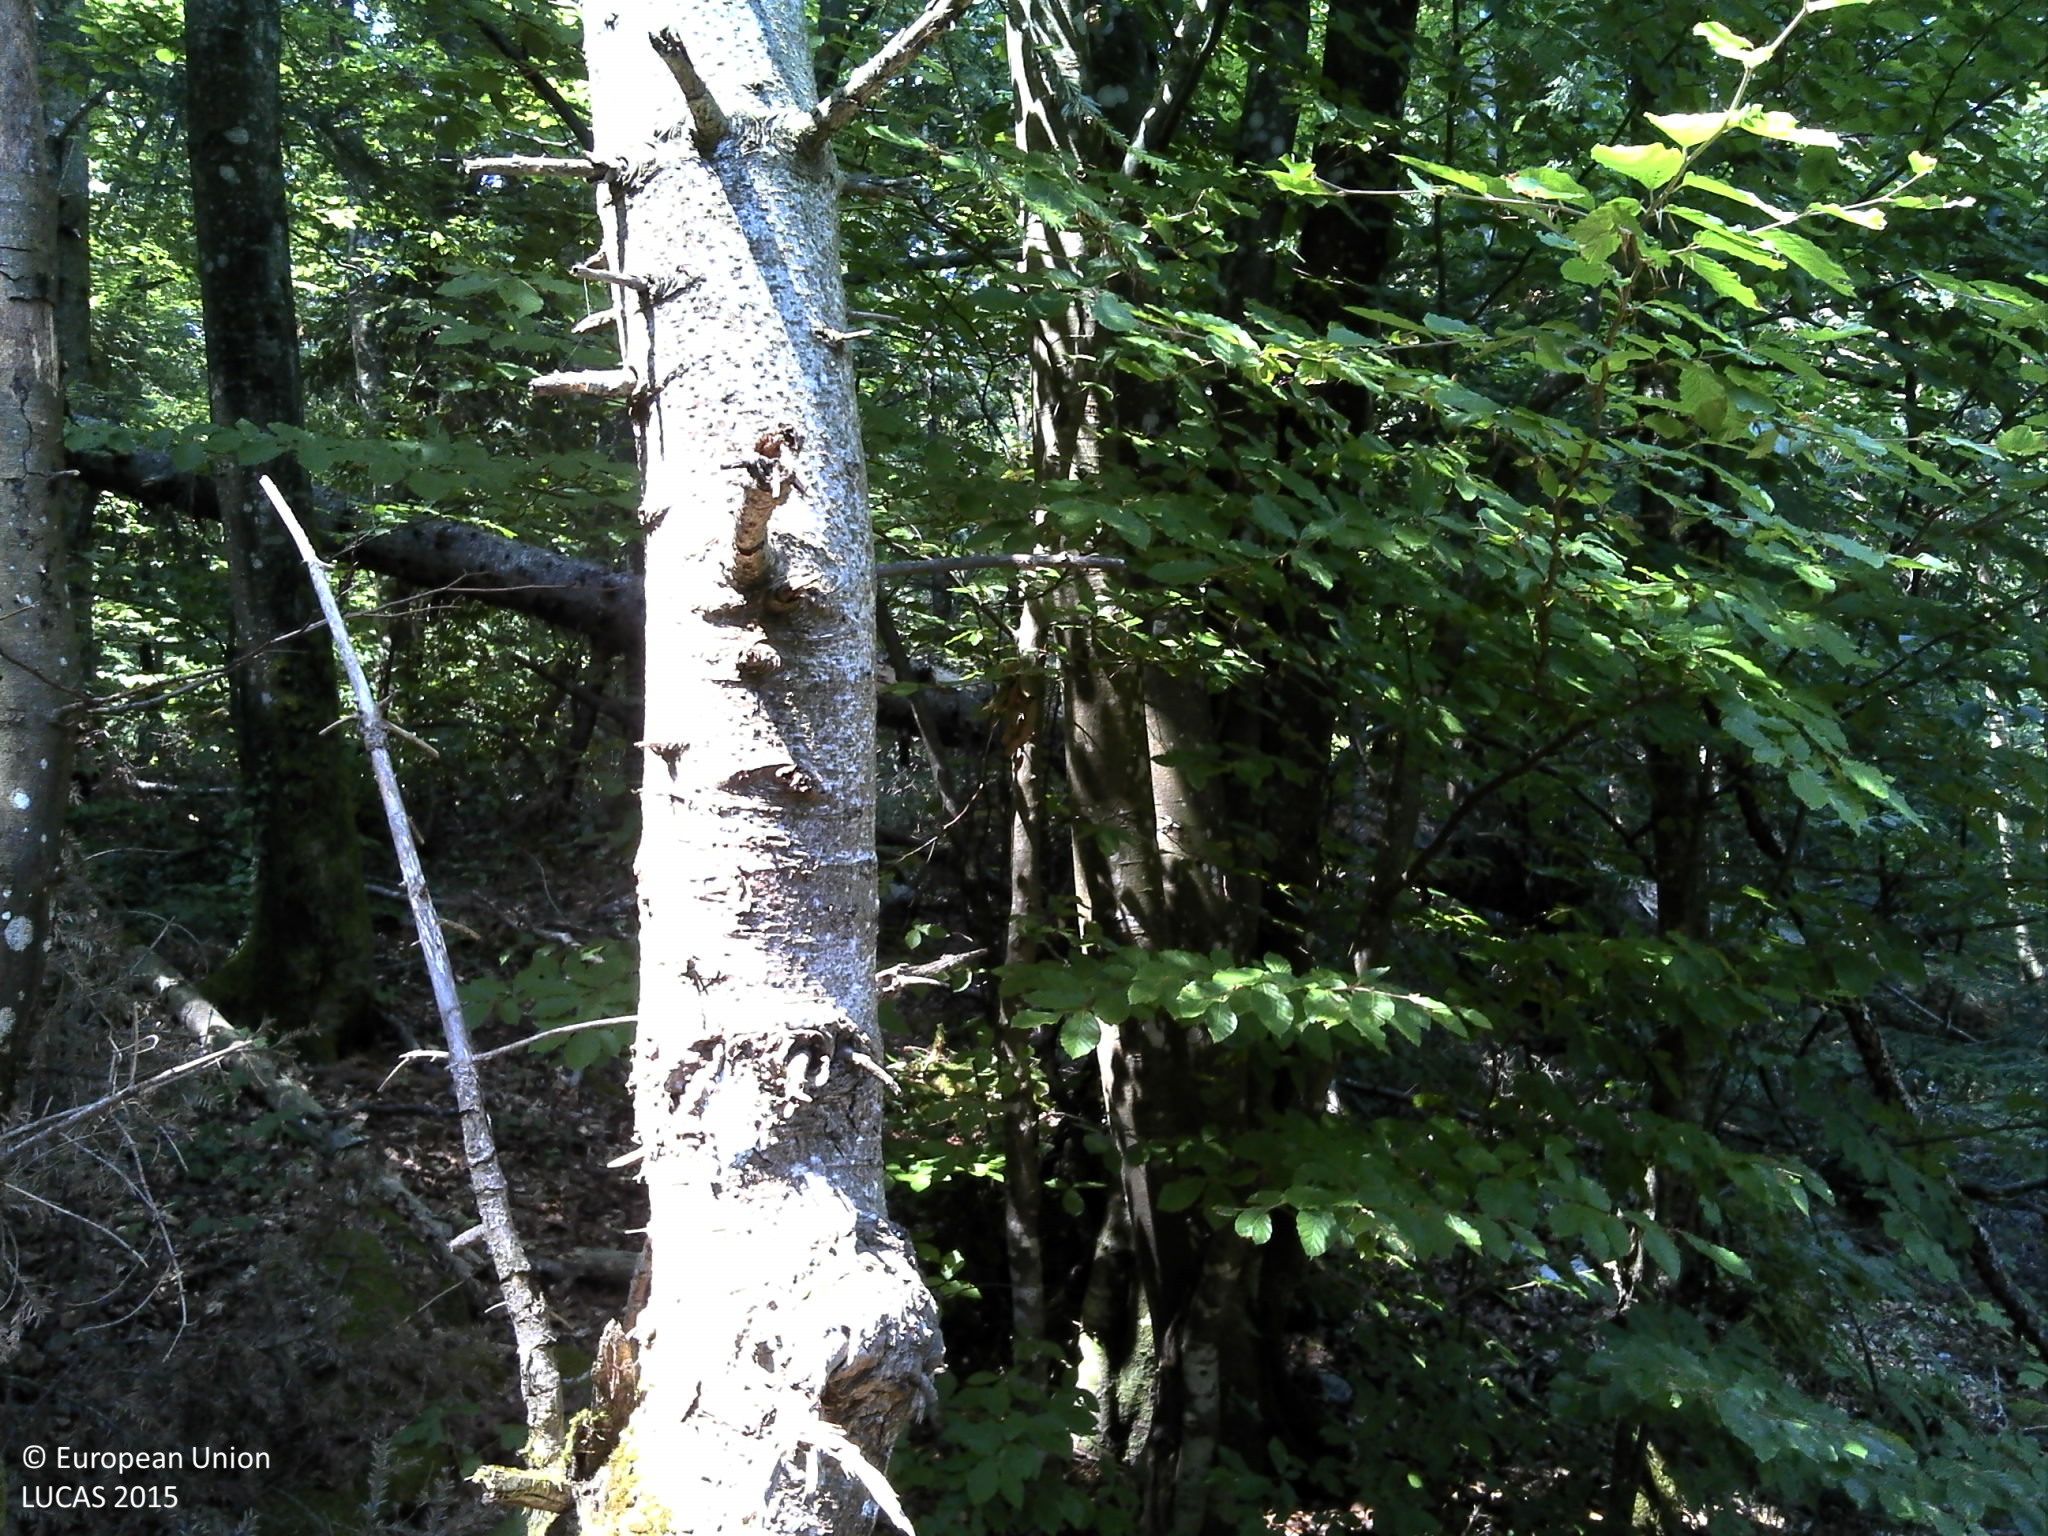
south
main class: Woodland
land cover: Spruce dominated mixed woodland
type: alpine coniferous forest
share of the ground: > 75 %
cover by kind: coniferous forest trees 50 %, broadleaved forest trees 30 %, shrubs 10 %, lichens and mosses 5 %, consolidated bare surface 5 %
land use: Forestry
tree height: > 5 m
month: July
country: HR
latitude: 45.0134
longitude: 15.2351
